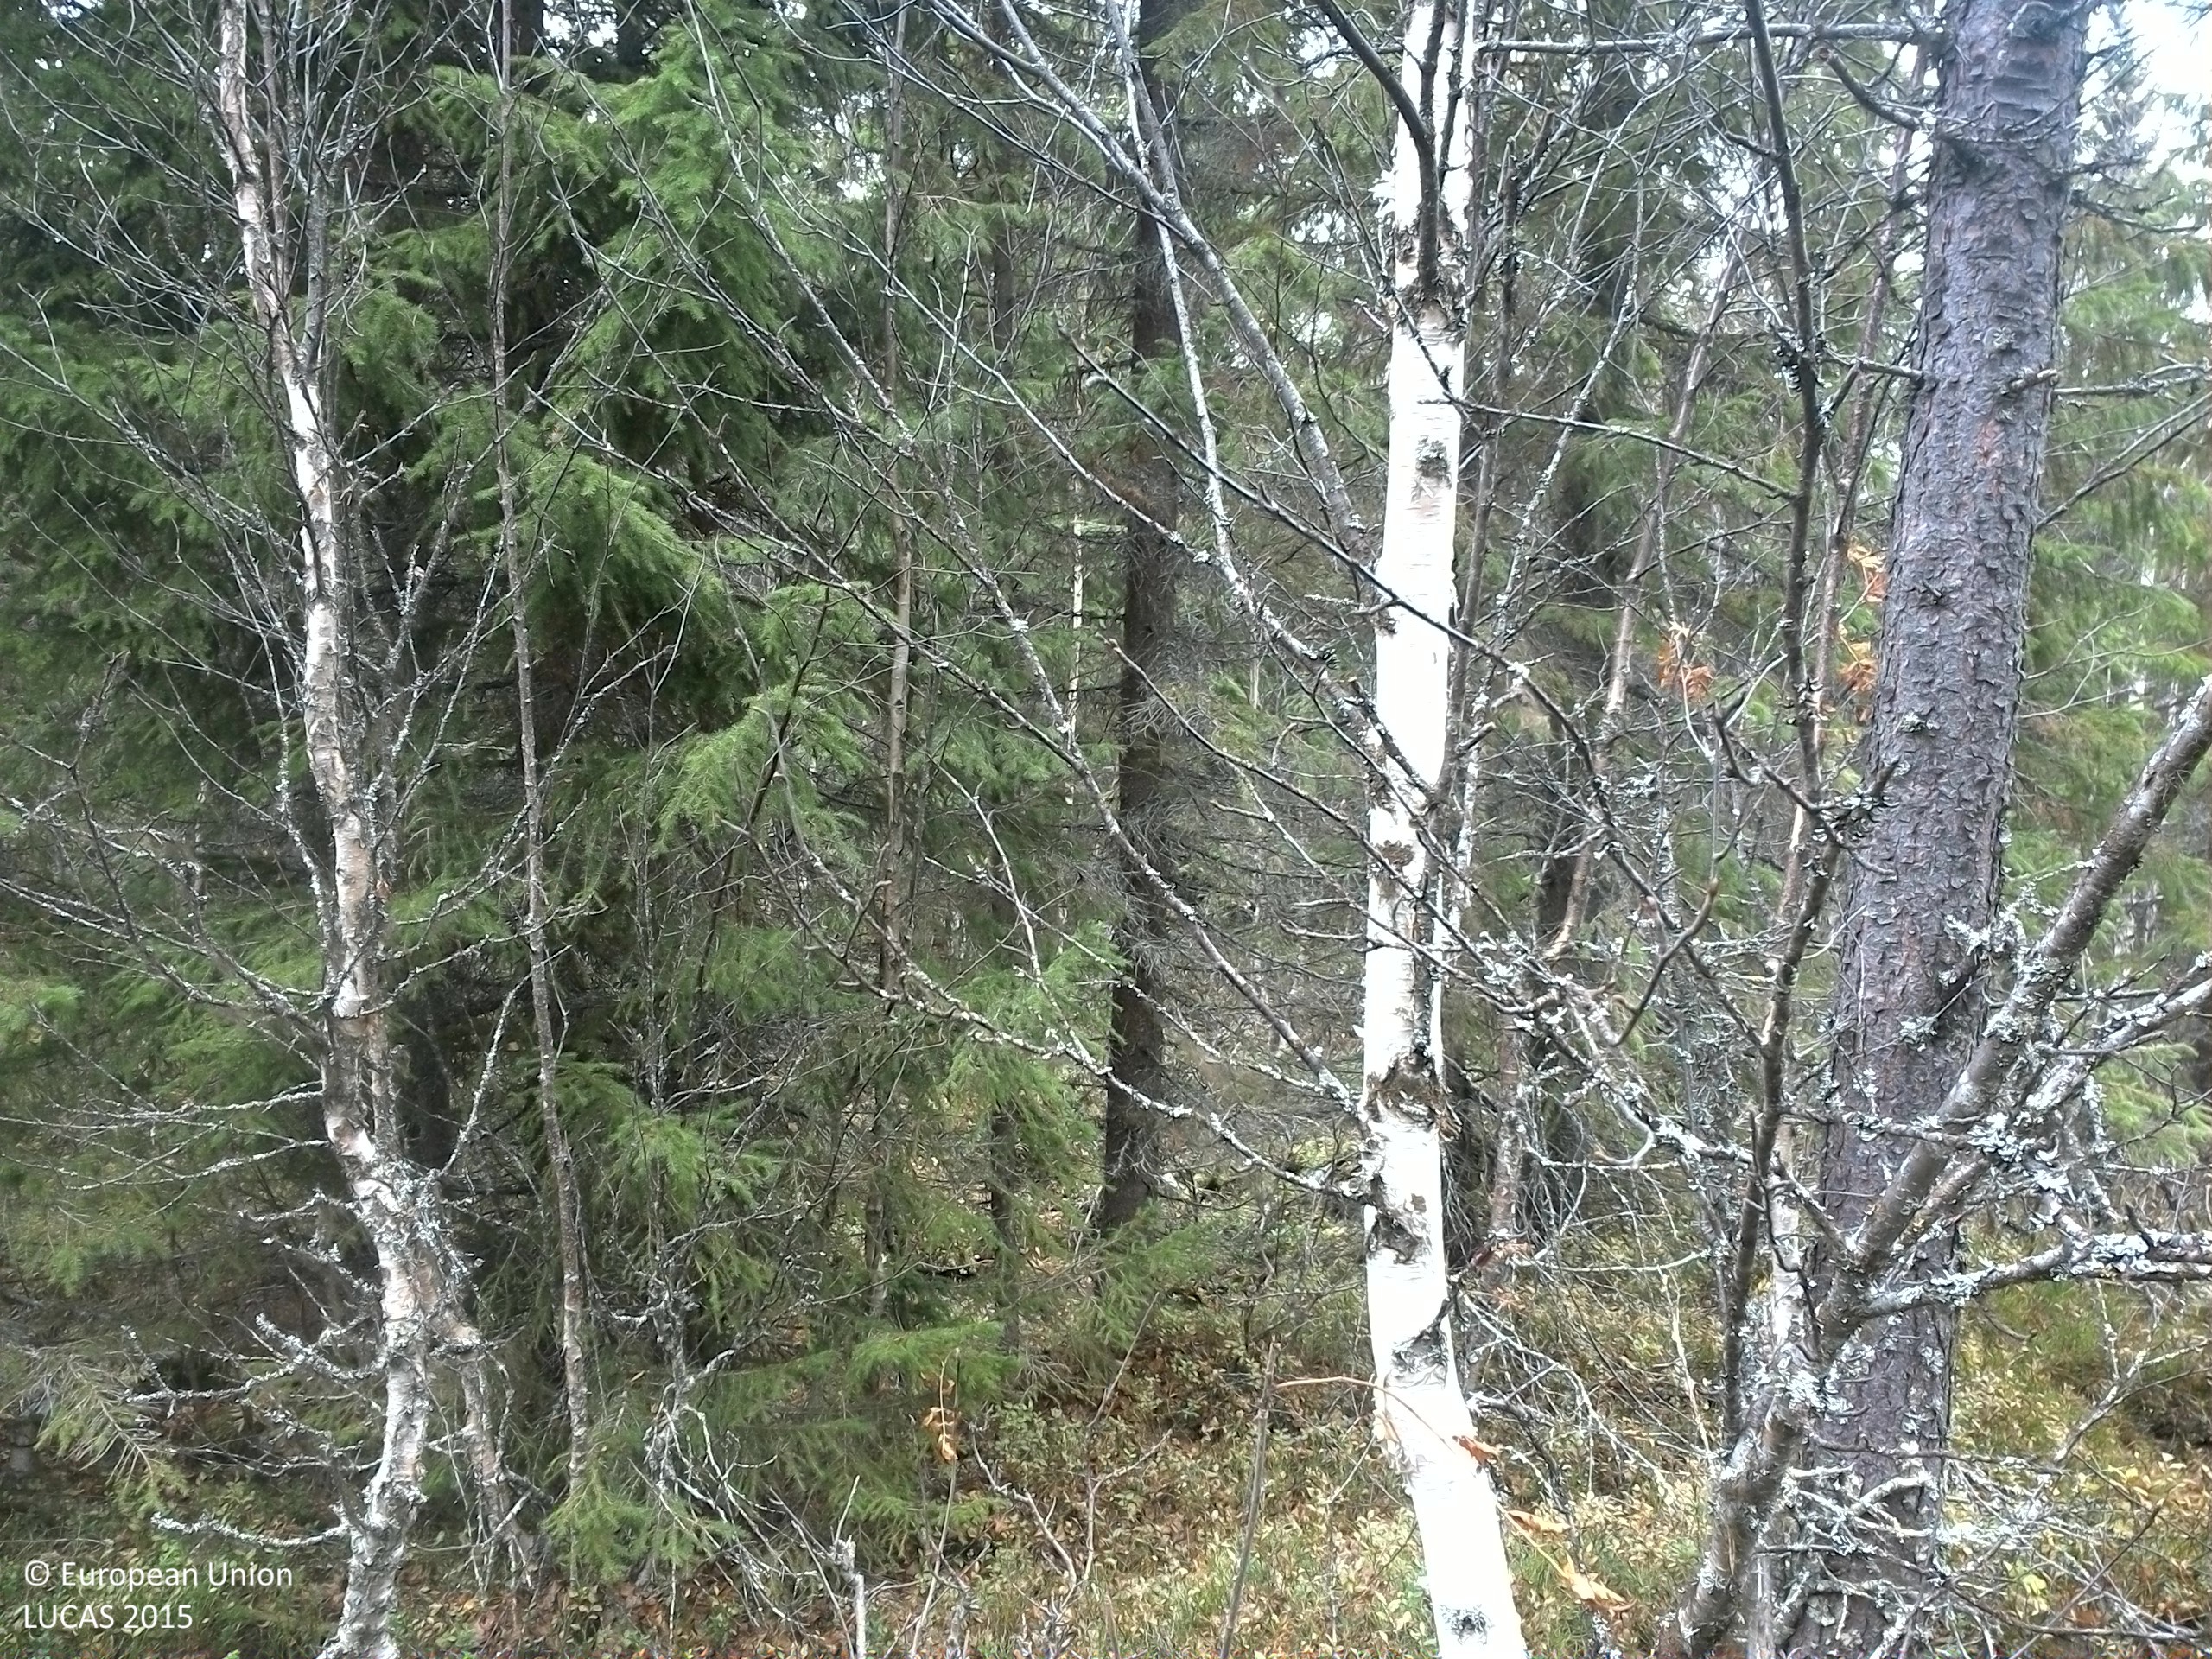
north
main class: Woodland
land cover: Spruce dominated mixed woodland
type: boreal forest
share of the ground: 50 - 75 %
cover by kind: coniferous forest trees 30 %, broadleaved forest trees 25 %, shrubs 20 %, herbaceous plants 15 %, lichens and mosses 10 %
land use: Forestry
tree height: > 5 m
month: October
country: SE
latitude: 64.3931
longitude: 15.5076
